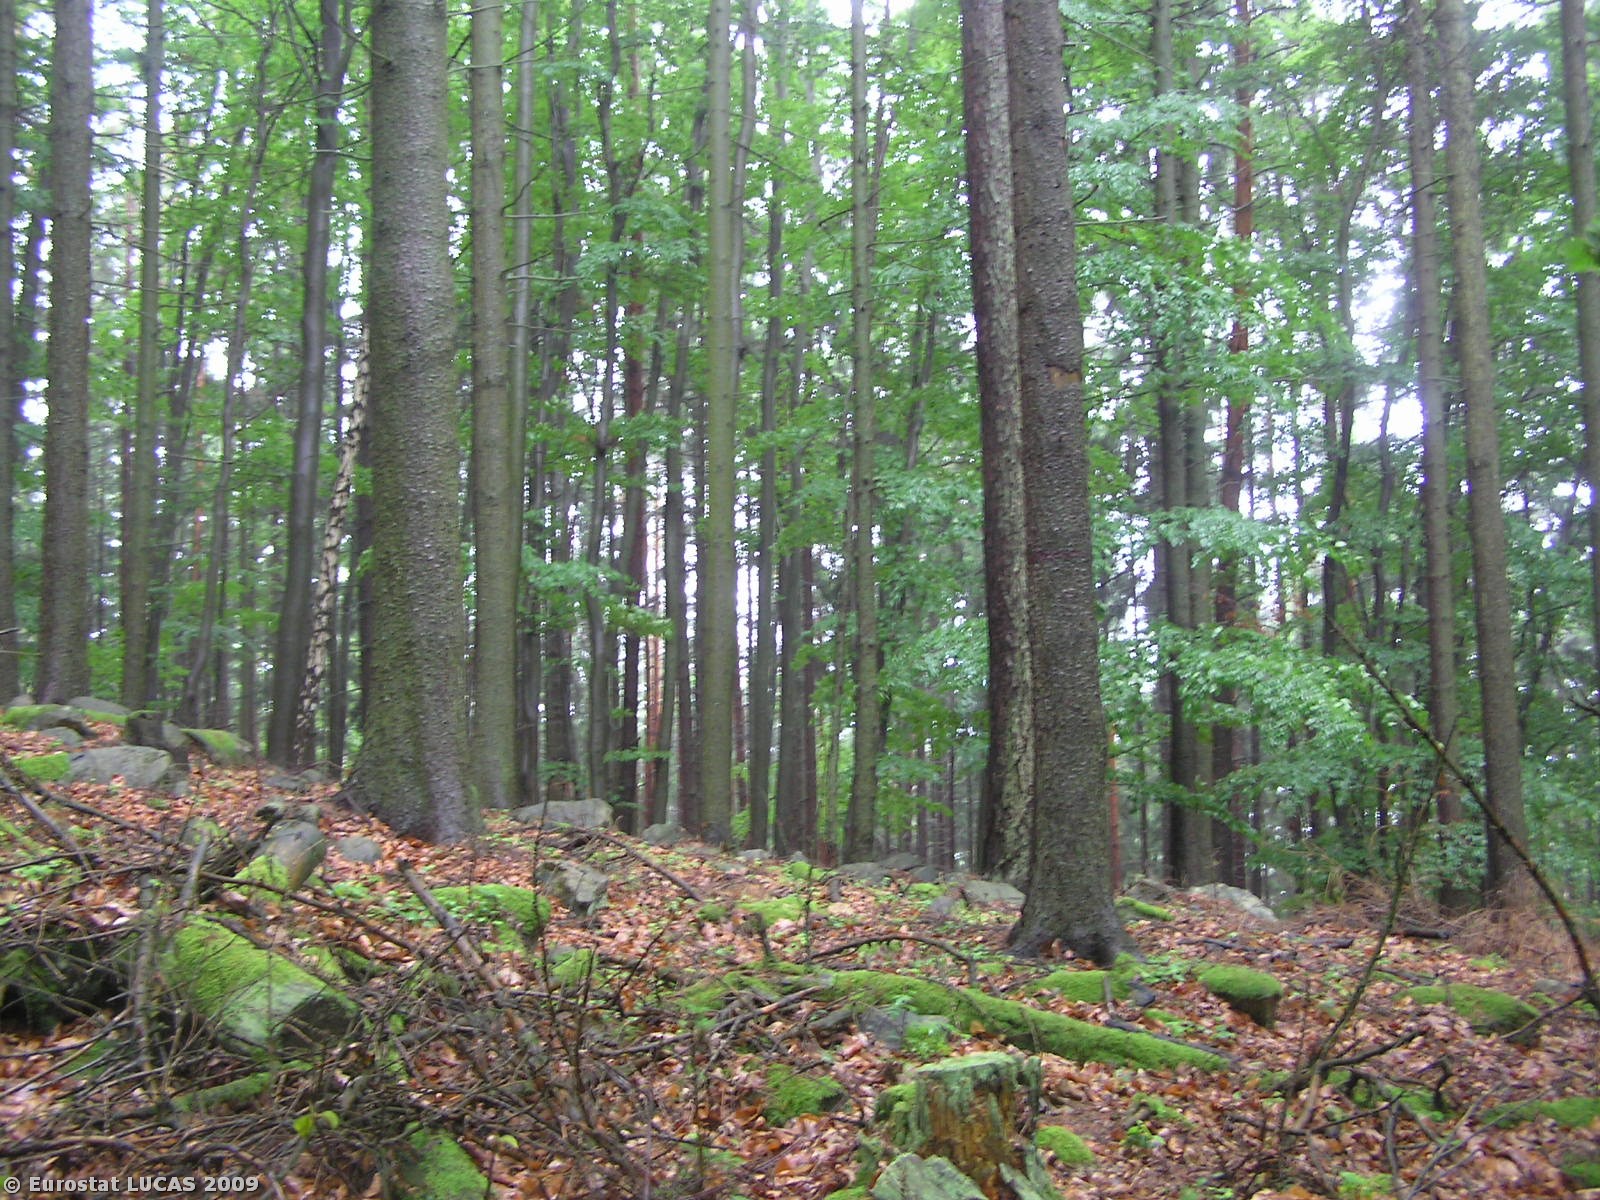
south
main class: Woodland
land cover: Mixed woodland
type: hemiboreal forest and nemoral coniferous forest and mixed broadleaved-coniferous forest
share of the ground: > 75 %
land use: Forestry
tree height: > 5 m
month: June
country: CZ
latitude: 49.6302
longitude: 14.8618
